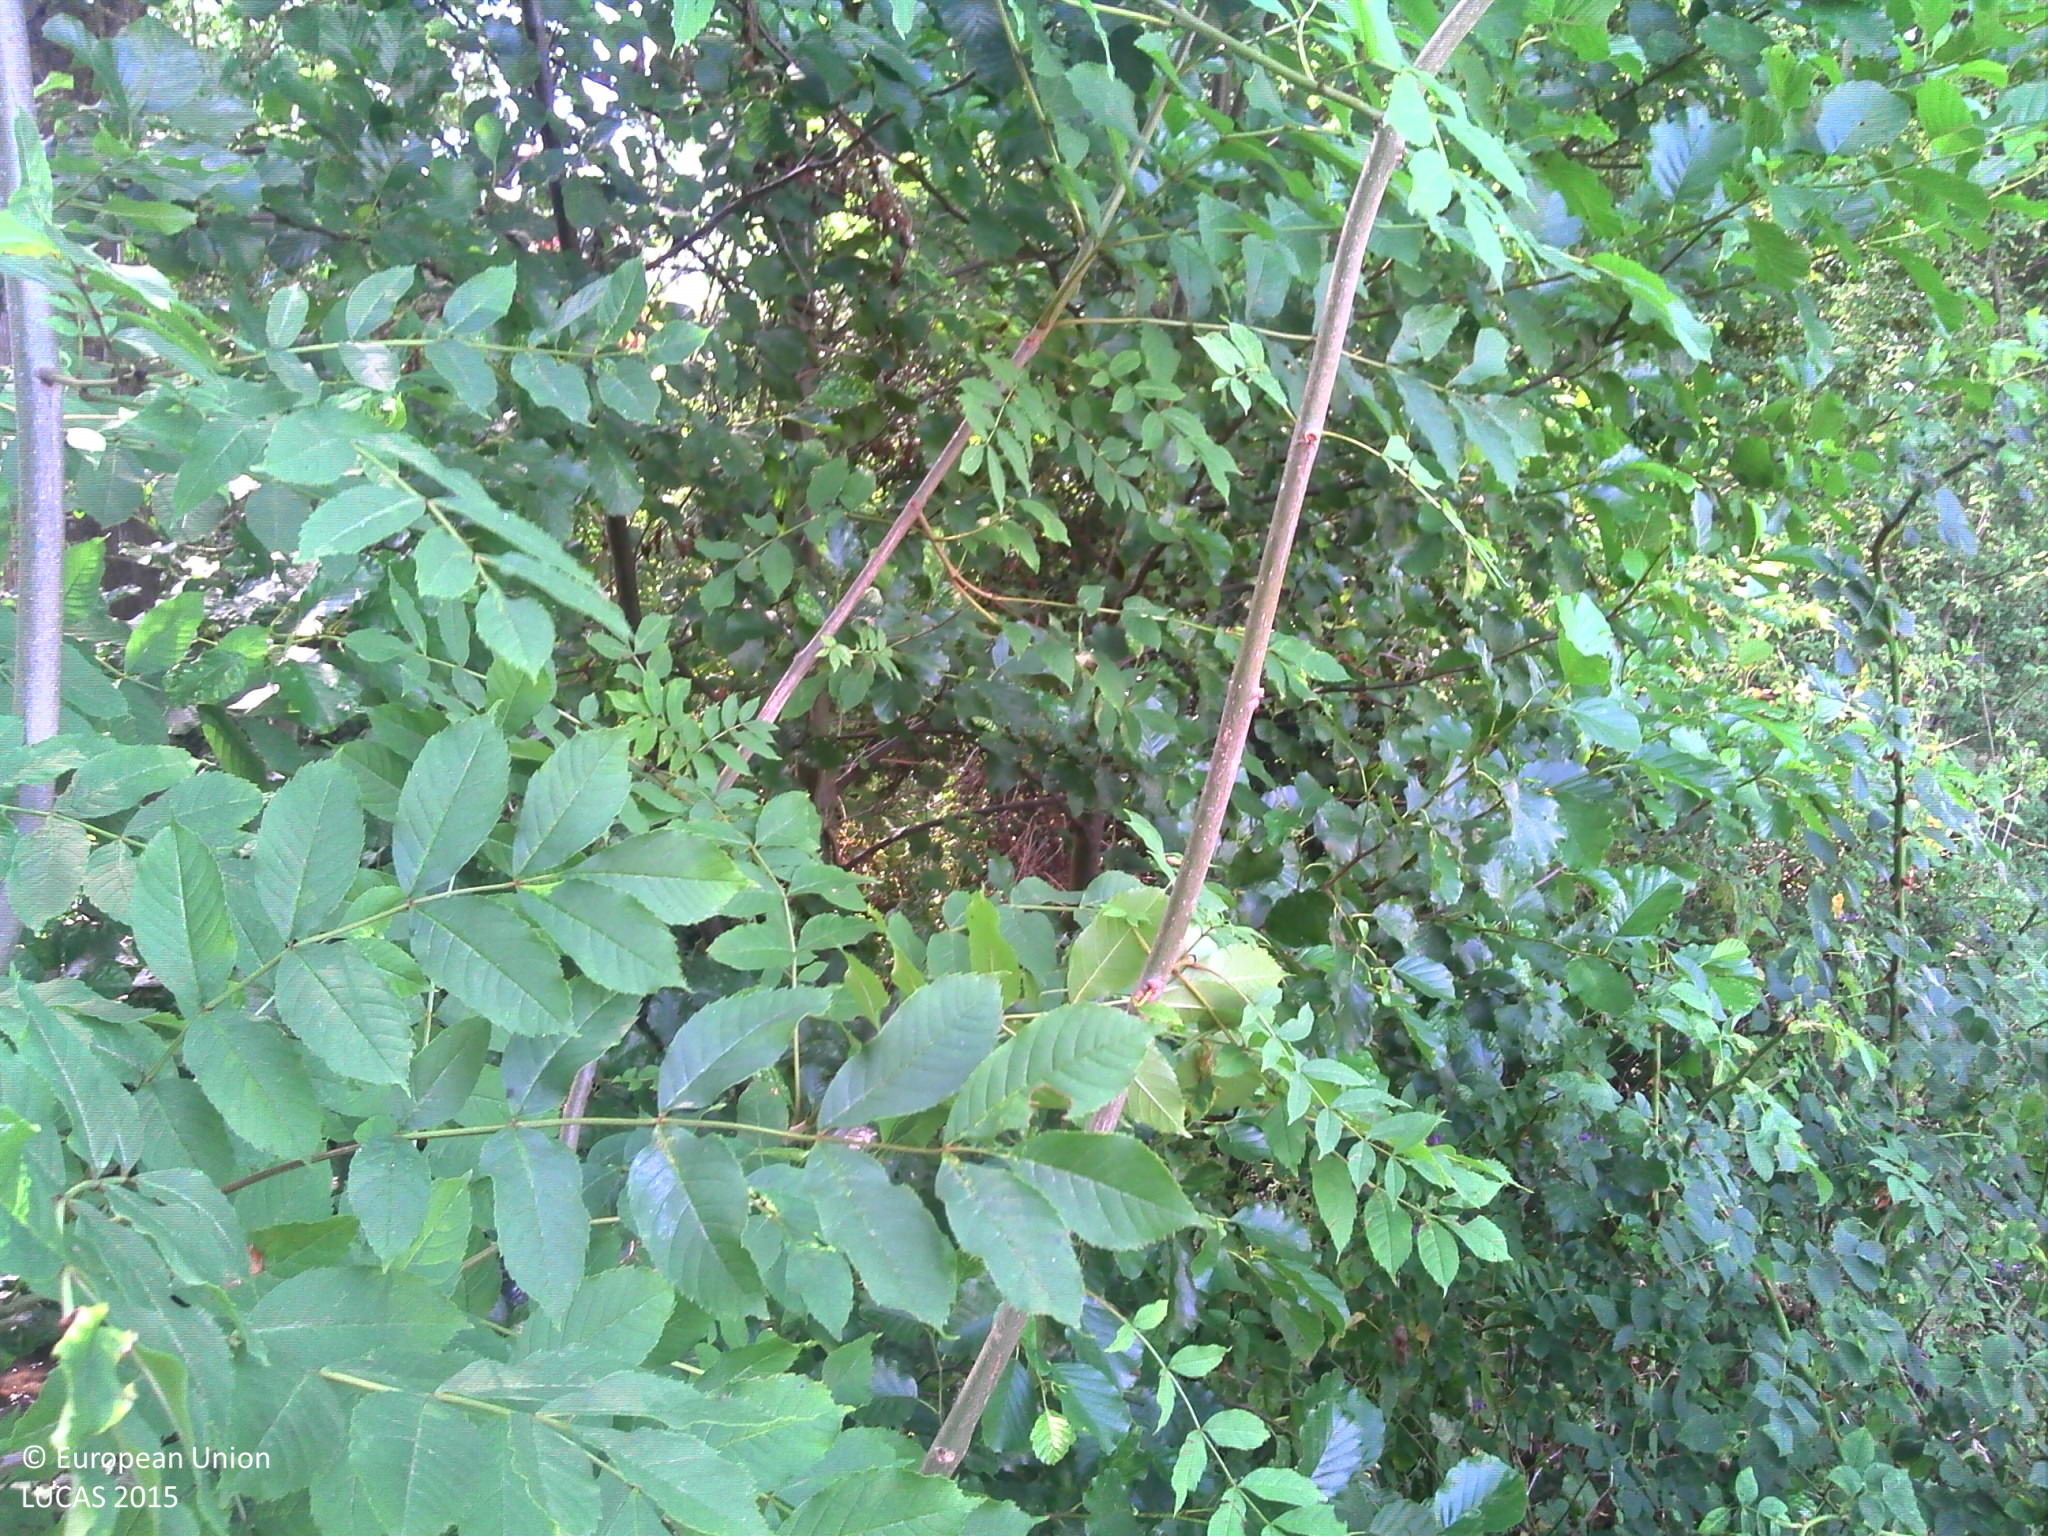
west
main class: Woodland
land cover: Broadleaved woodland
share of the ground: > 75 %
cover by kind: broadleaved forest trees 80 %, shrubs 10 %, herbaceous plants 5 %, lichens and mosses 5 %
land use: Semi-natural and natural areas not in use
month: July
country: FR
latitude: 48.3784
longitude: 1.4366
